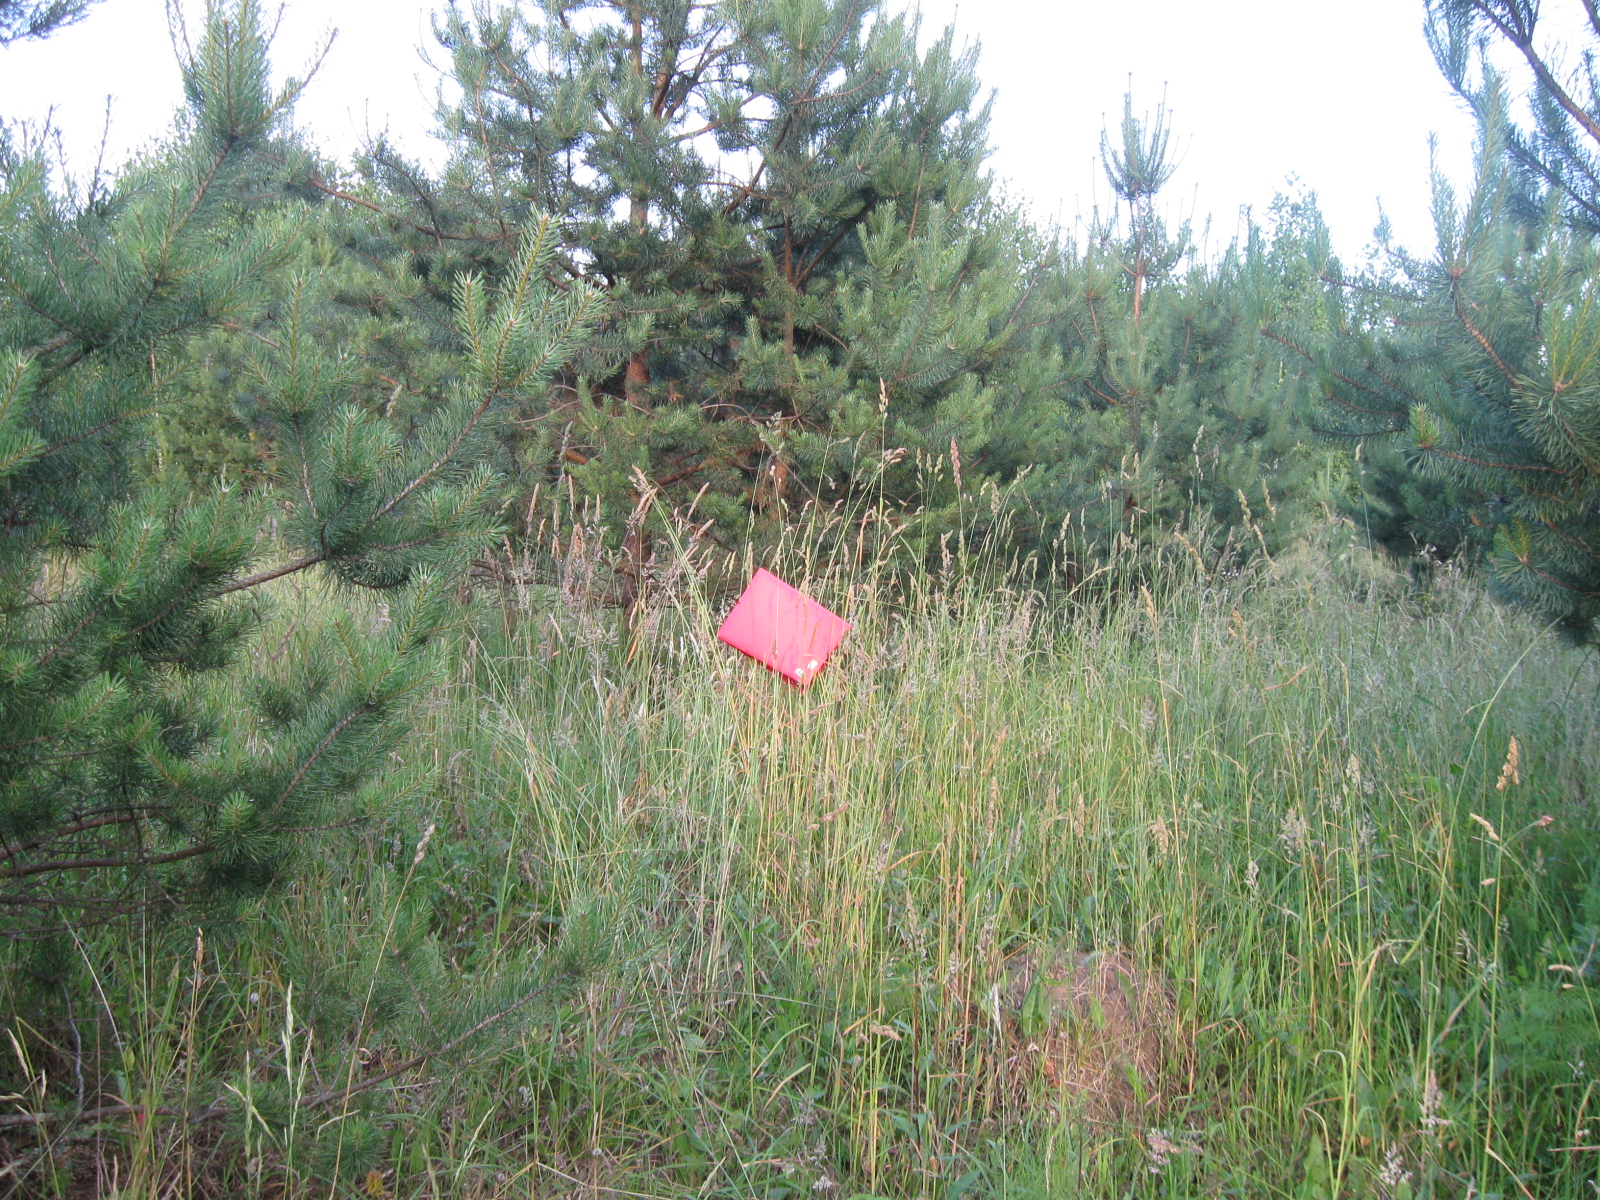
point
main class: Woodland
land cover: Pine dominated coniferous woodland
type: hemiboreal forest and nemoral coniferous forest and mixed broadleaved-coniferous forest
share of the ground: 50 - 75 %
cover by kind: coniferous forest trees 60 %, herbaceous plants 40 %
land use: Forestry
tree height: < 5 m
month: June
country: LT
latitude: 54.2021
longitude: 24.2163
